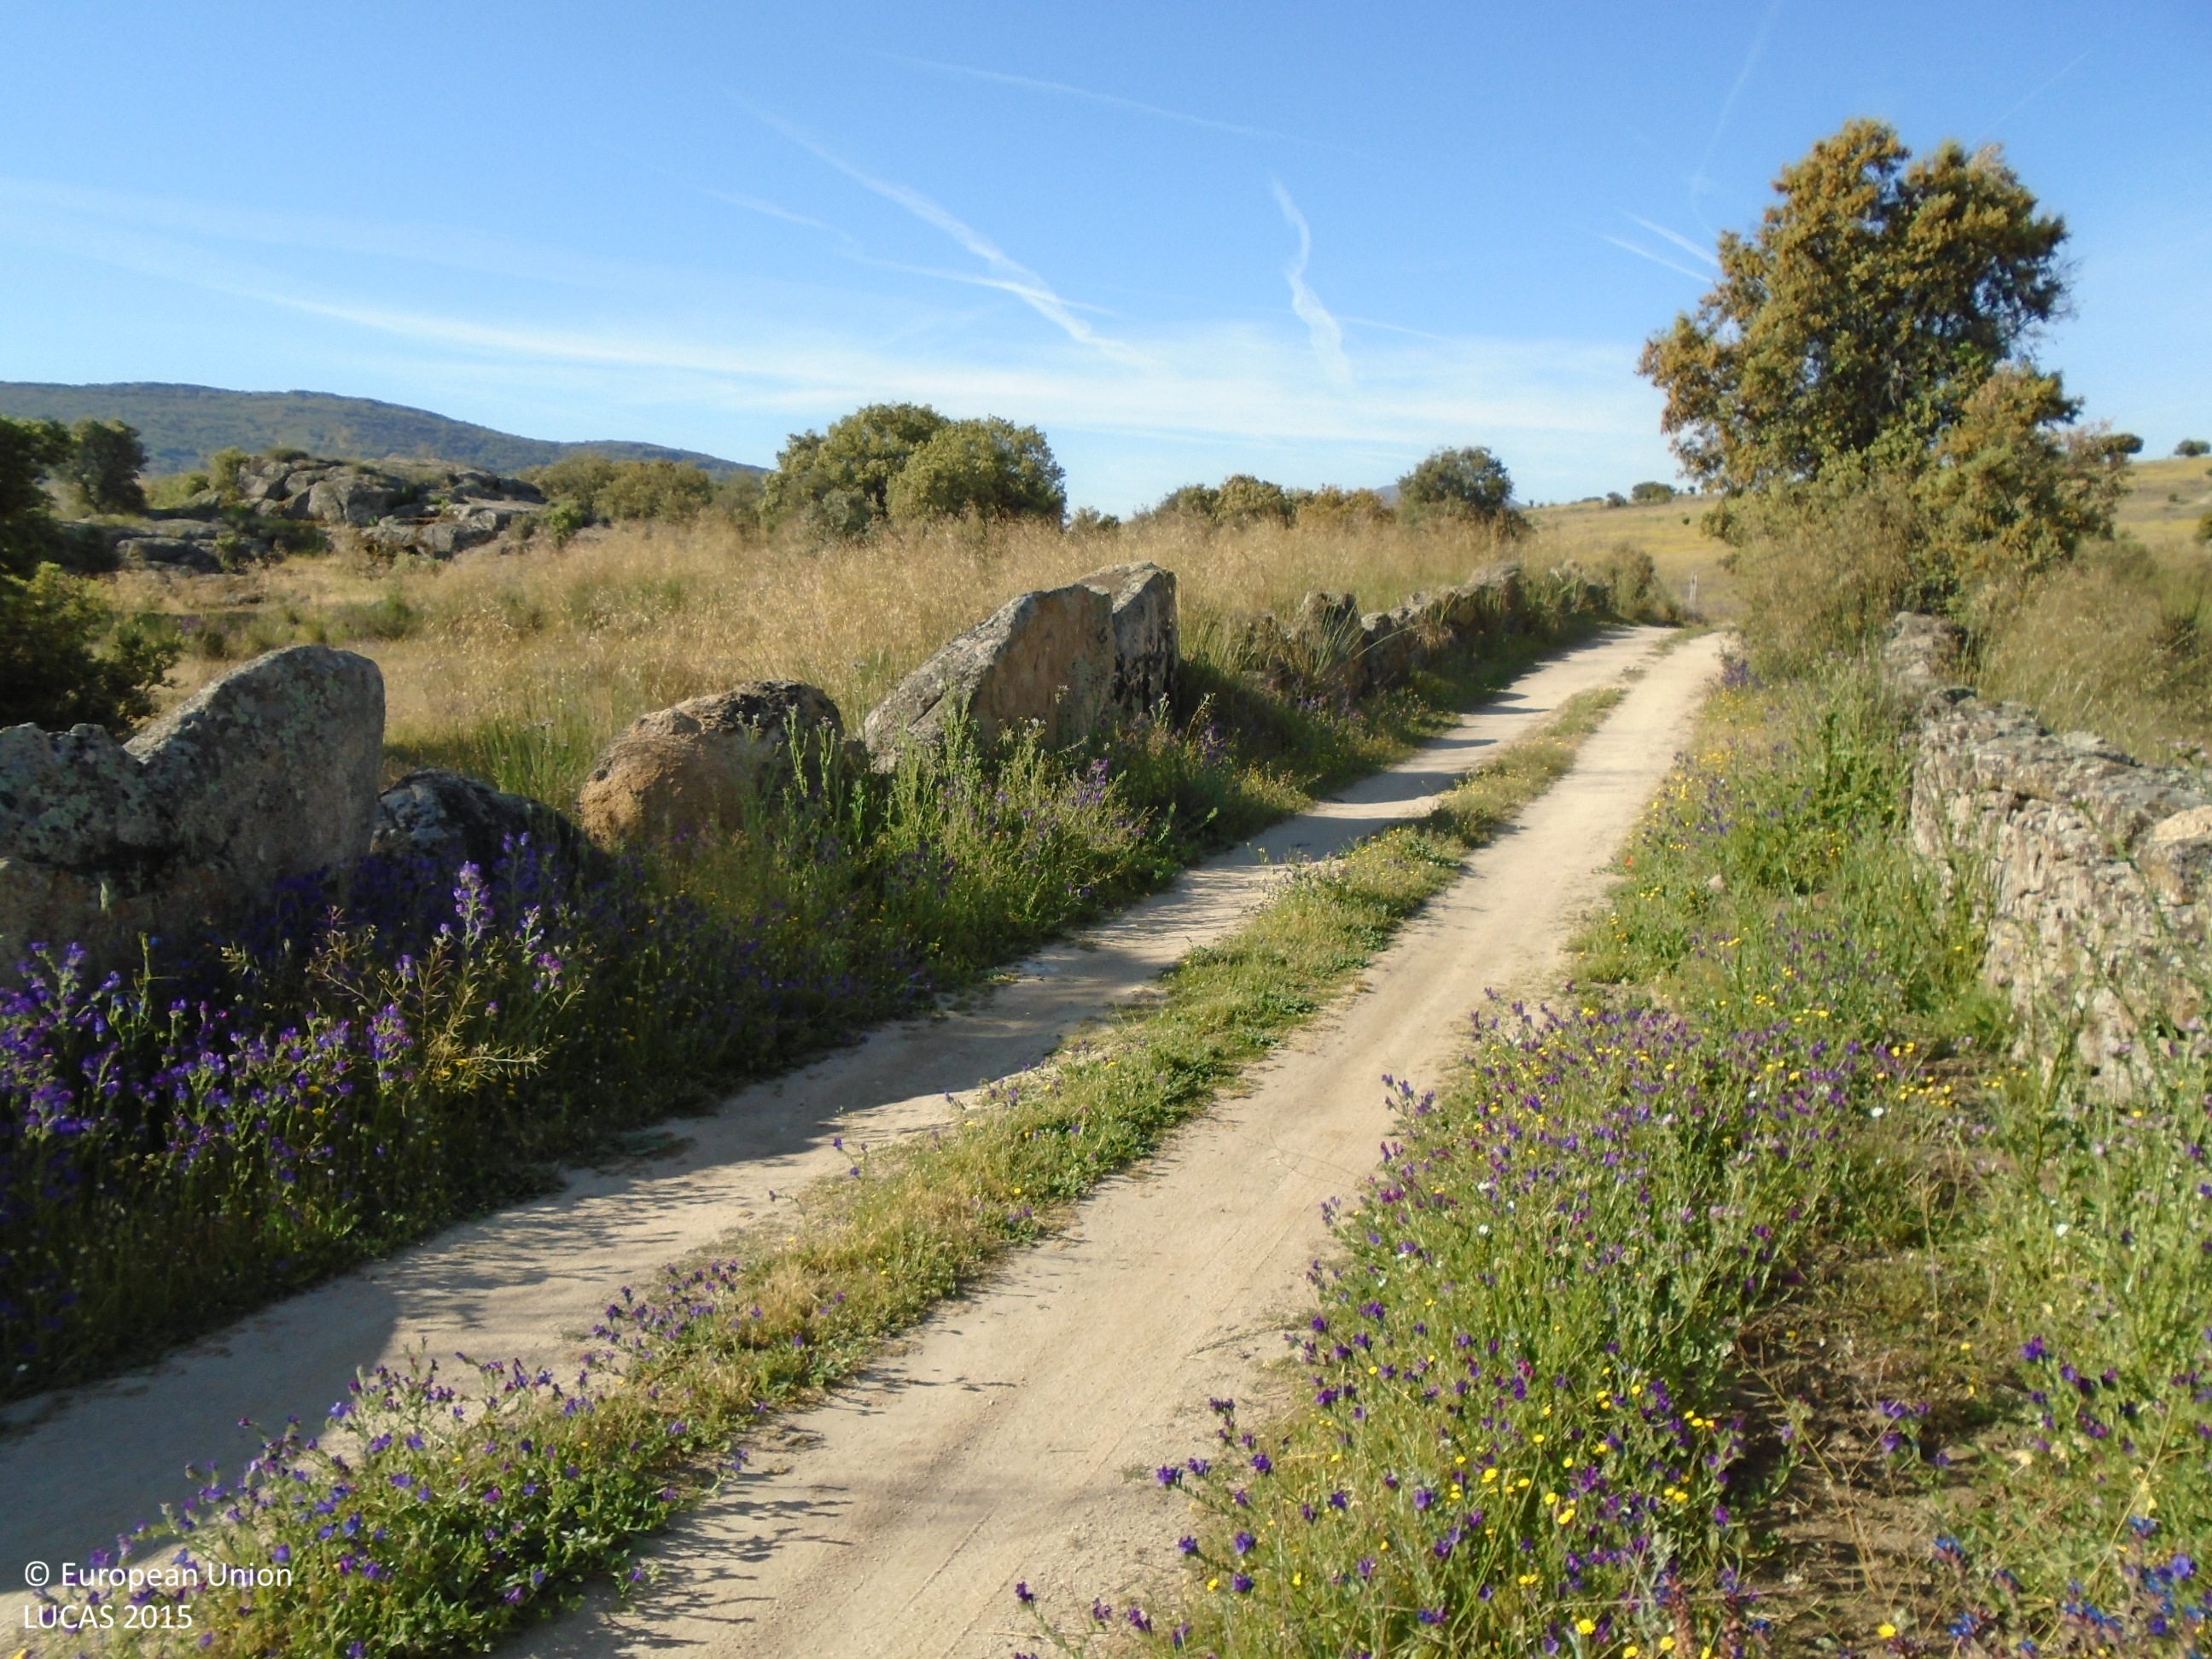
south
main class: Grassland
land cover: Grassland without tree/shrub cover
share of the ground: > 75 %
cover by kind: herbaceous plants 95 %, consolidated bare surface 5 %
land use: Agriculture (excluding fallow land and kitchen gardens)
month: May
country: ES
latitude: 39.5914
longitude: -4.2276
